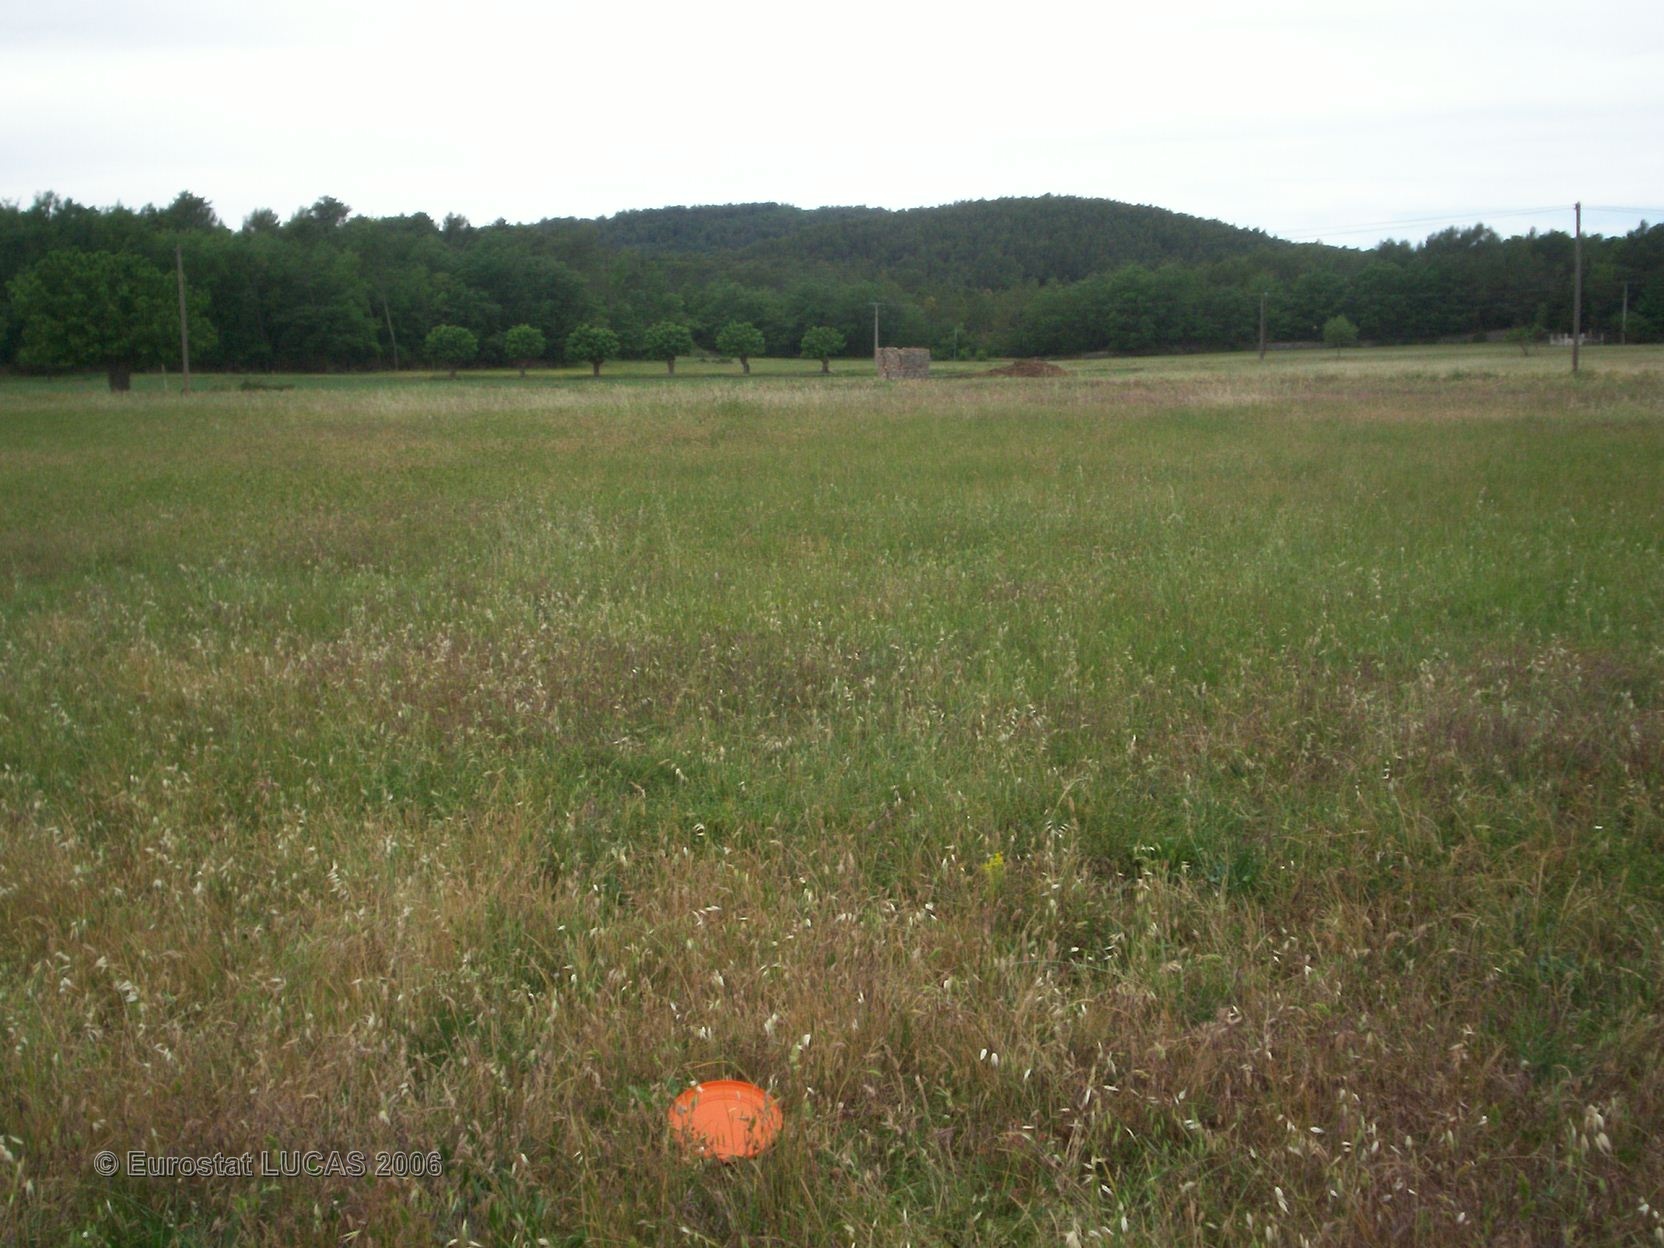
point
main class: Grassland
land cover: Grassland without tree/shrub cover
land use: Agriculture (excluding fallow land and kitchen gardens)
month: May
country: FR
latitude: 43.5711
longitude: 6.5537
